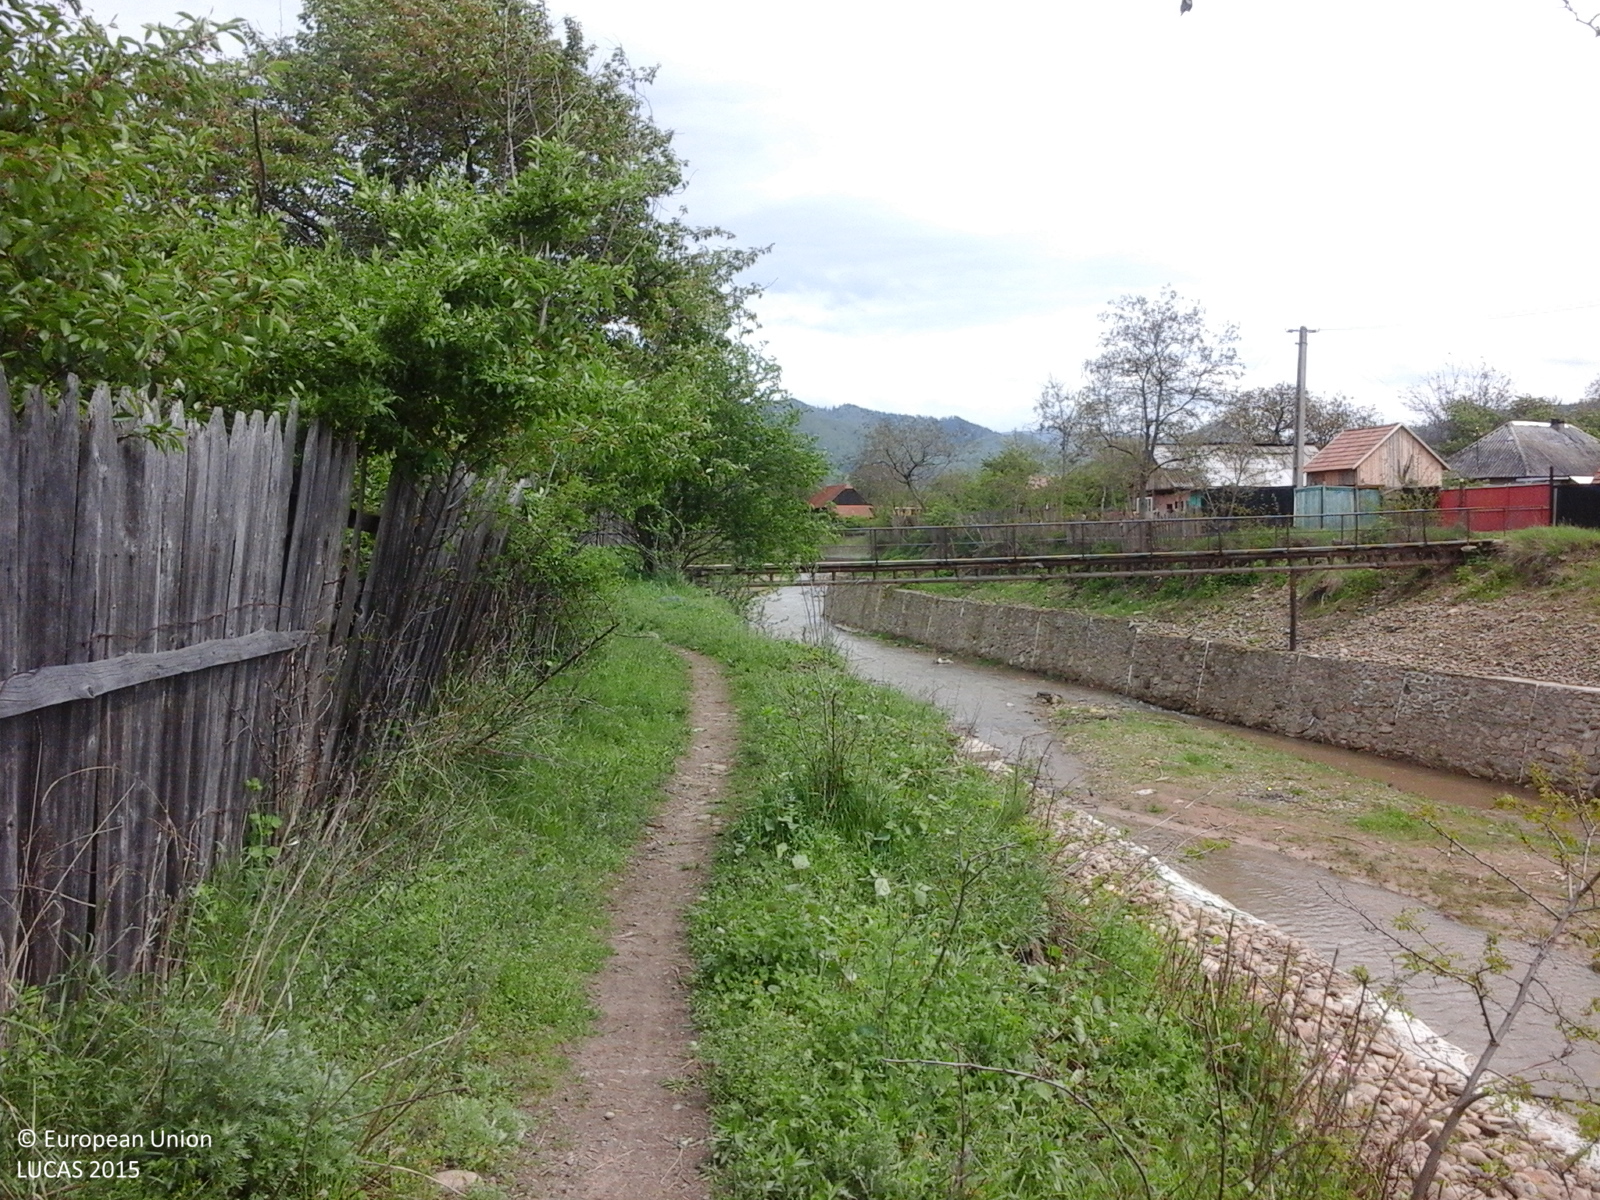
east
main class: Woodland
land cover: Broadleaved woodland
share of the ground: 50 - 75 %
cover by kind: broadleaved forest trees 100 %
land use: Residential
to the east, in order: Broadleaved woodland; Grassland with sparse tree/shrub cover; Fences; Grass margins; Tracks; Grass margins; Fences; Shrubland with sparse tree cover; Fences; Grassland without tree/shrub cover; Fences; Grassland without tree/shrub cover; Fences; Shrubland with sparse tree cover; Fences; Grassland without tree/shrub cover; Fences; Grassland without tree/shrub cover; Fences; Lines of trees; Grassland without tree/shrub cover; Fences; Lines of trees; Grassland without tree/shrub cover; Lines of trees; Fences; Grassland without tree/shrub cover; Lines of trees; Fences; Grassland with sparse tree/shrub cover; Fences; Grassland without tree/shrub cover; Artificial constructions in urban areas
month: May
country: RO
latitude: 45.9449
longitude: 26.2342
